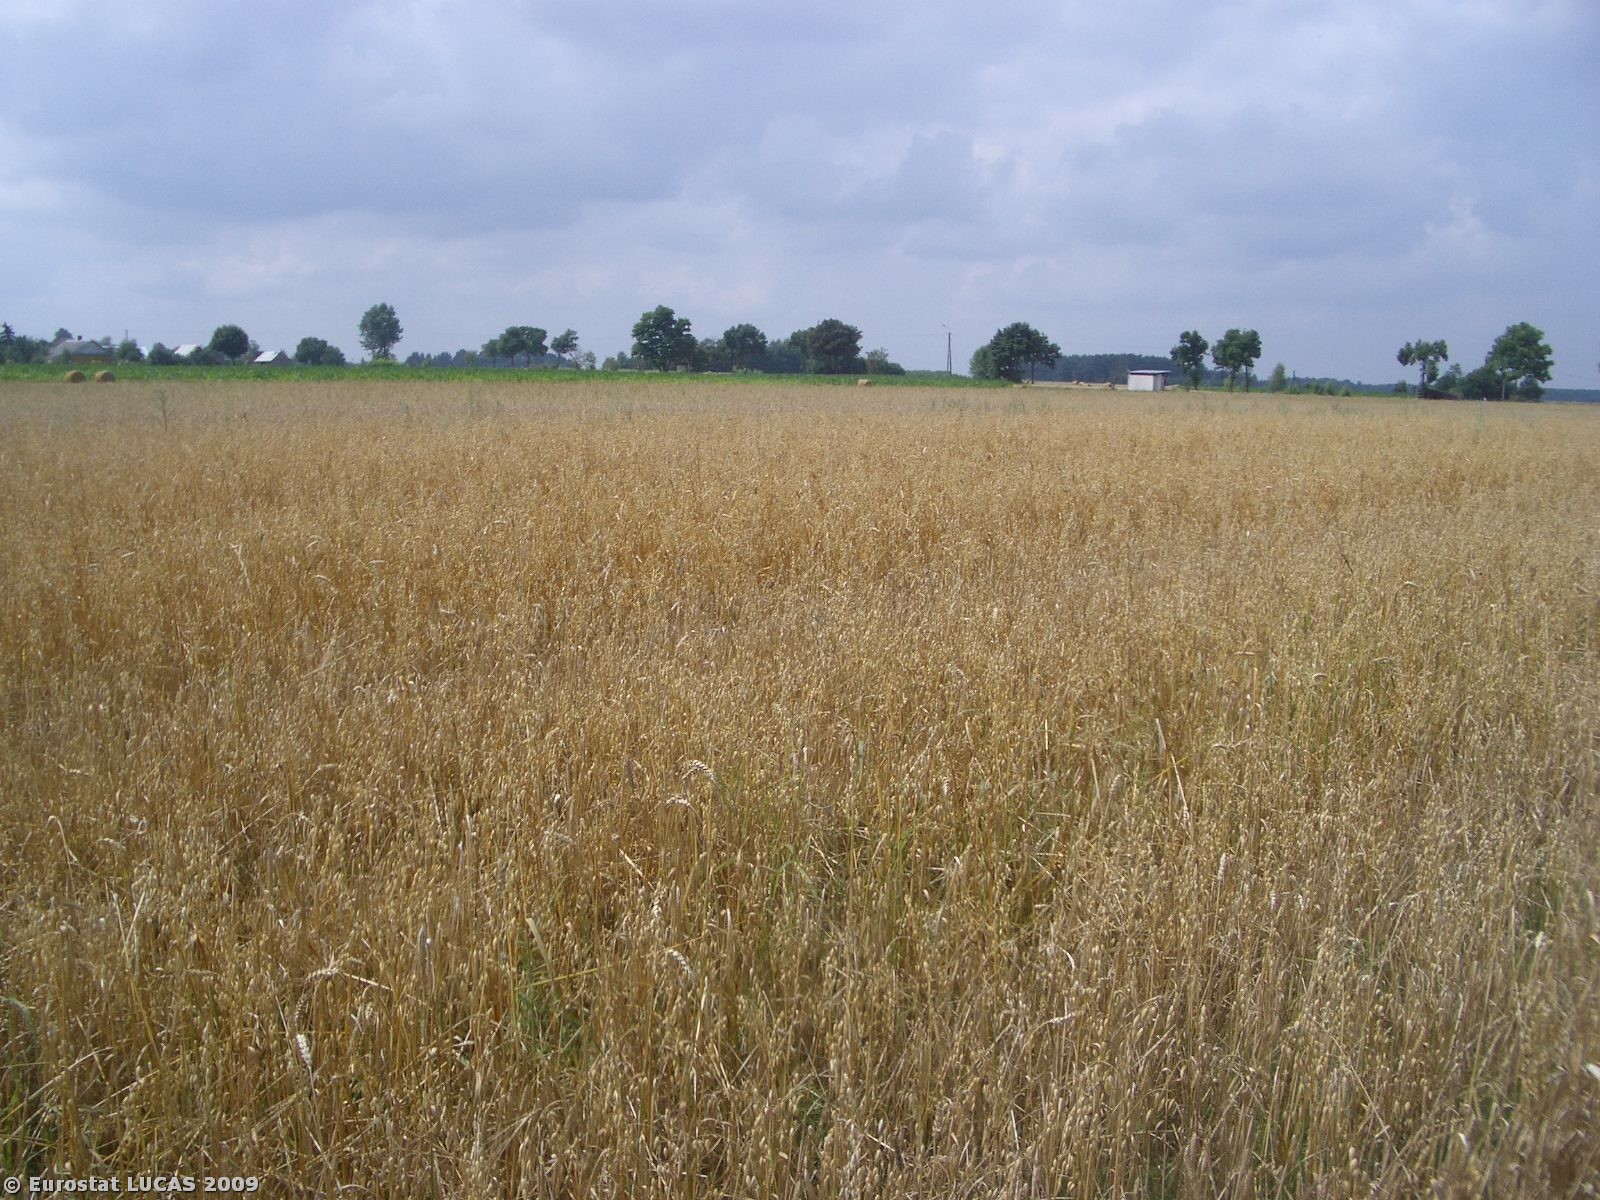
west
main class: Cropland
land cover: Oats
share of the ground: 50 - 75 %
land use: Agriculture (excluding fallow land and kitchen gardens)
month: August
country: PL
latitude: 51.7647
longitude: 23.1919
